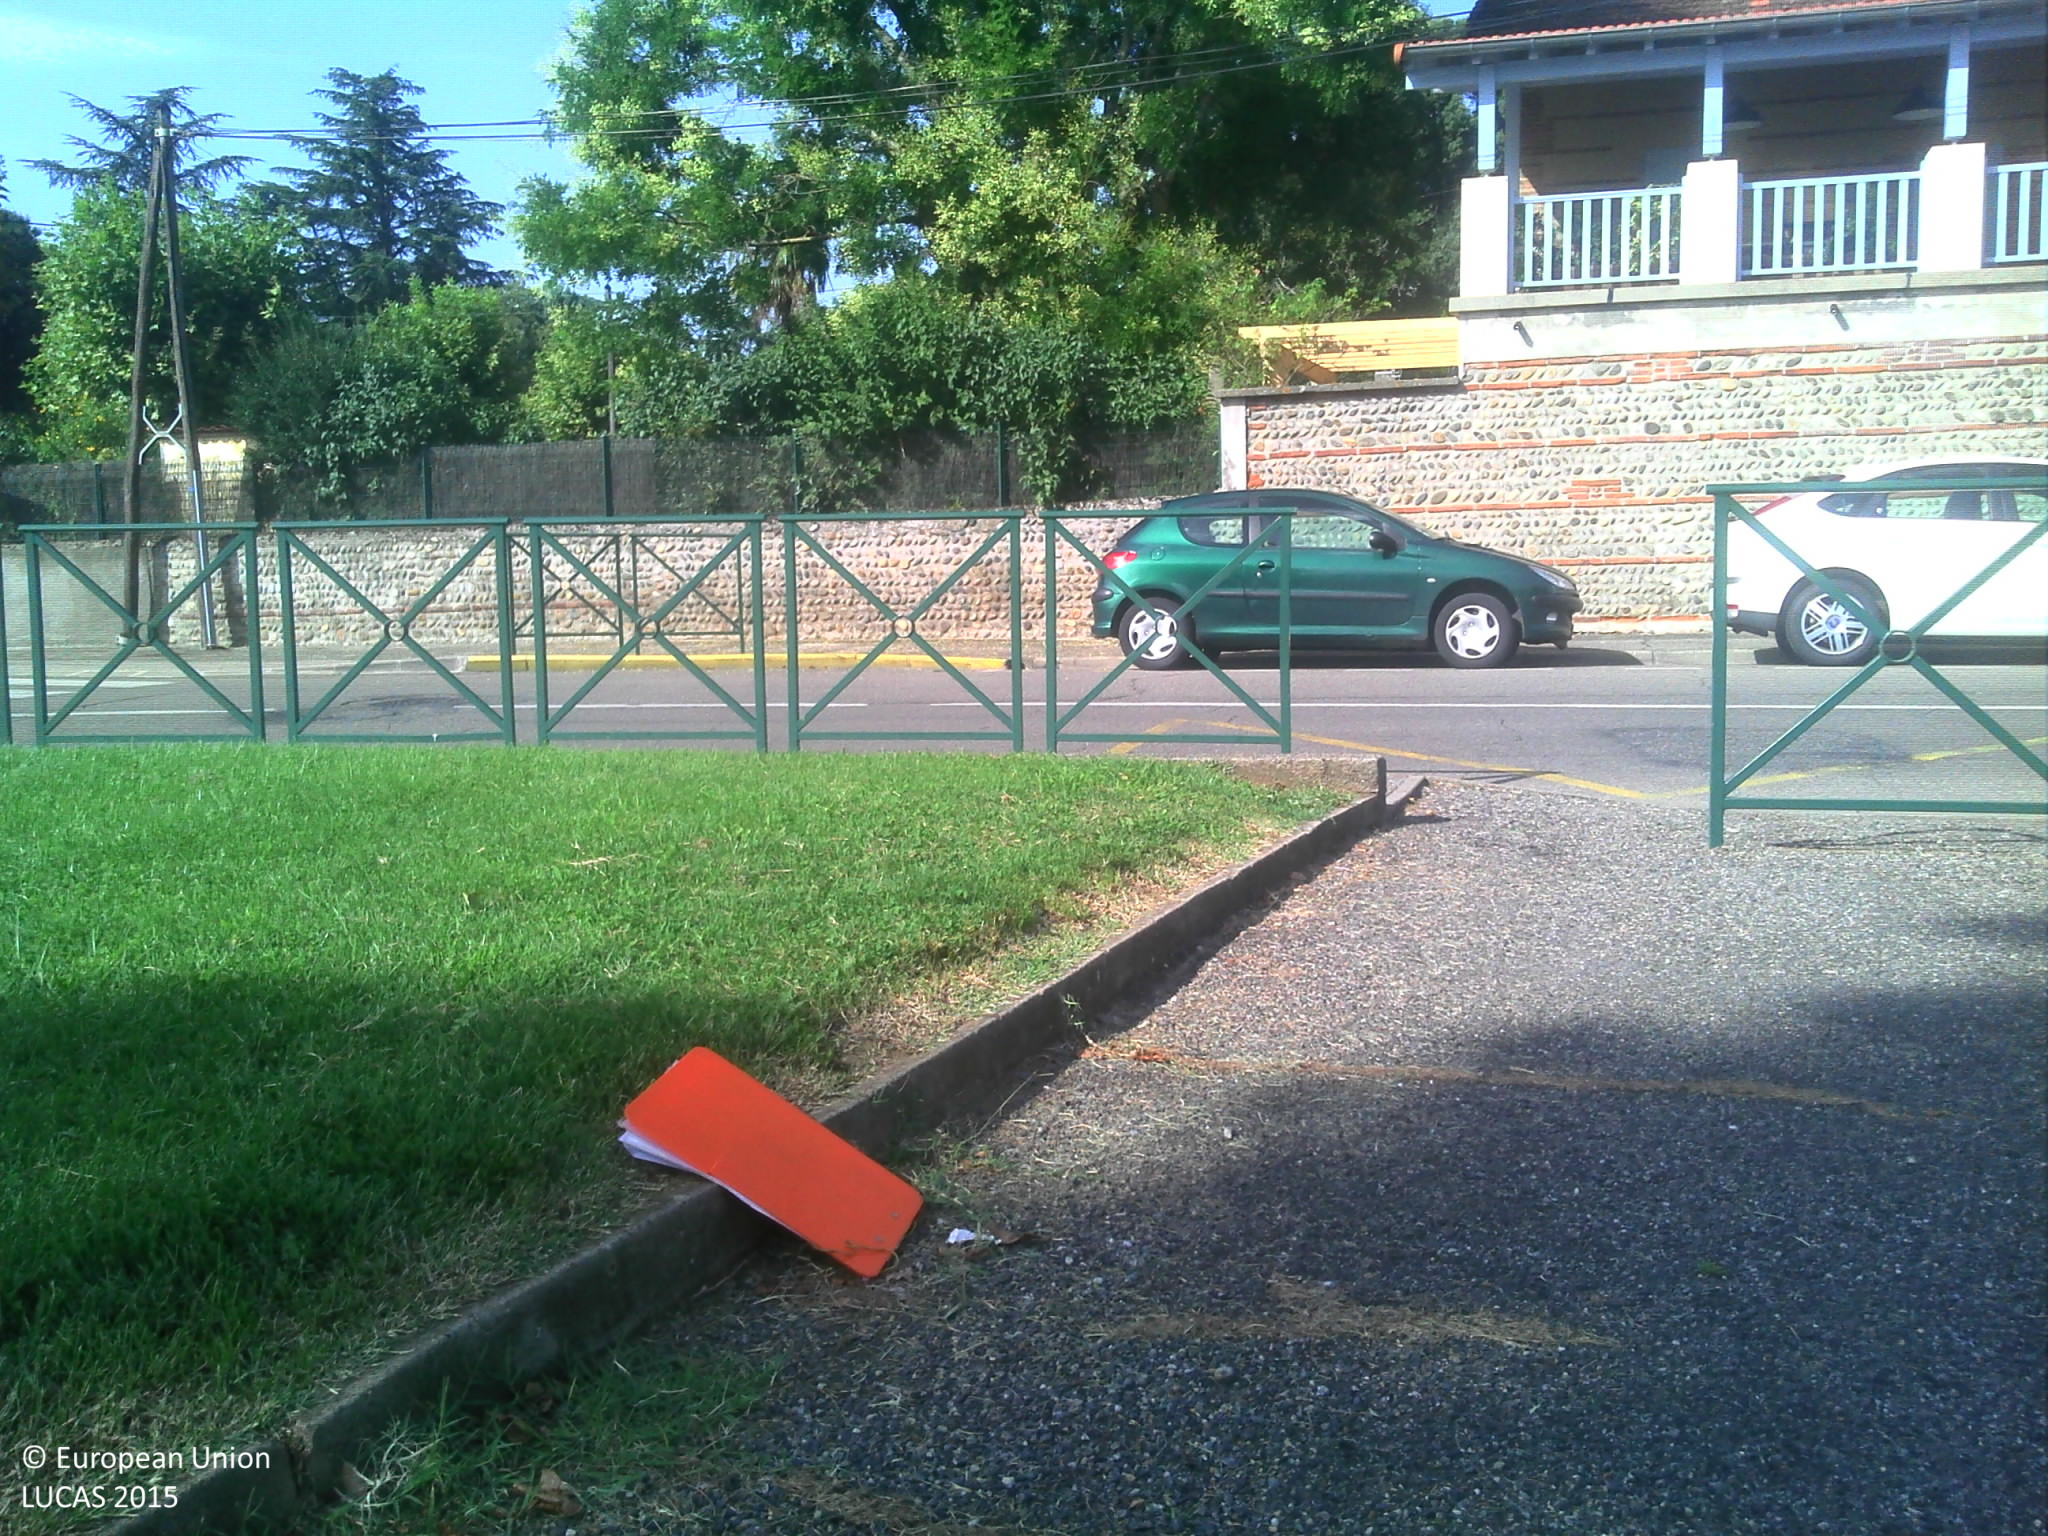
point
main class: Grassland
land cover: Grassland without tree/shrub cover
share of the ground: > 75 %
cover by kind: herbaceous plants 100 %
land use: Community services
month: August
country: FR
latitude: 43.5219
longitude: 1.4044
